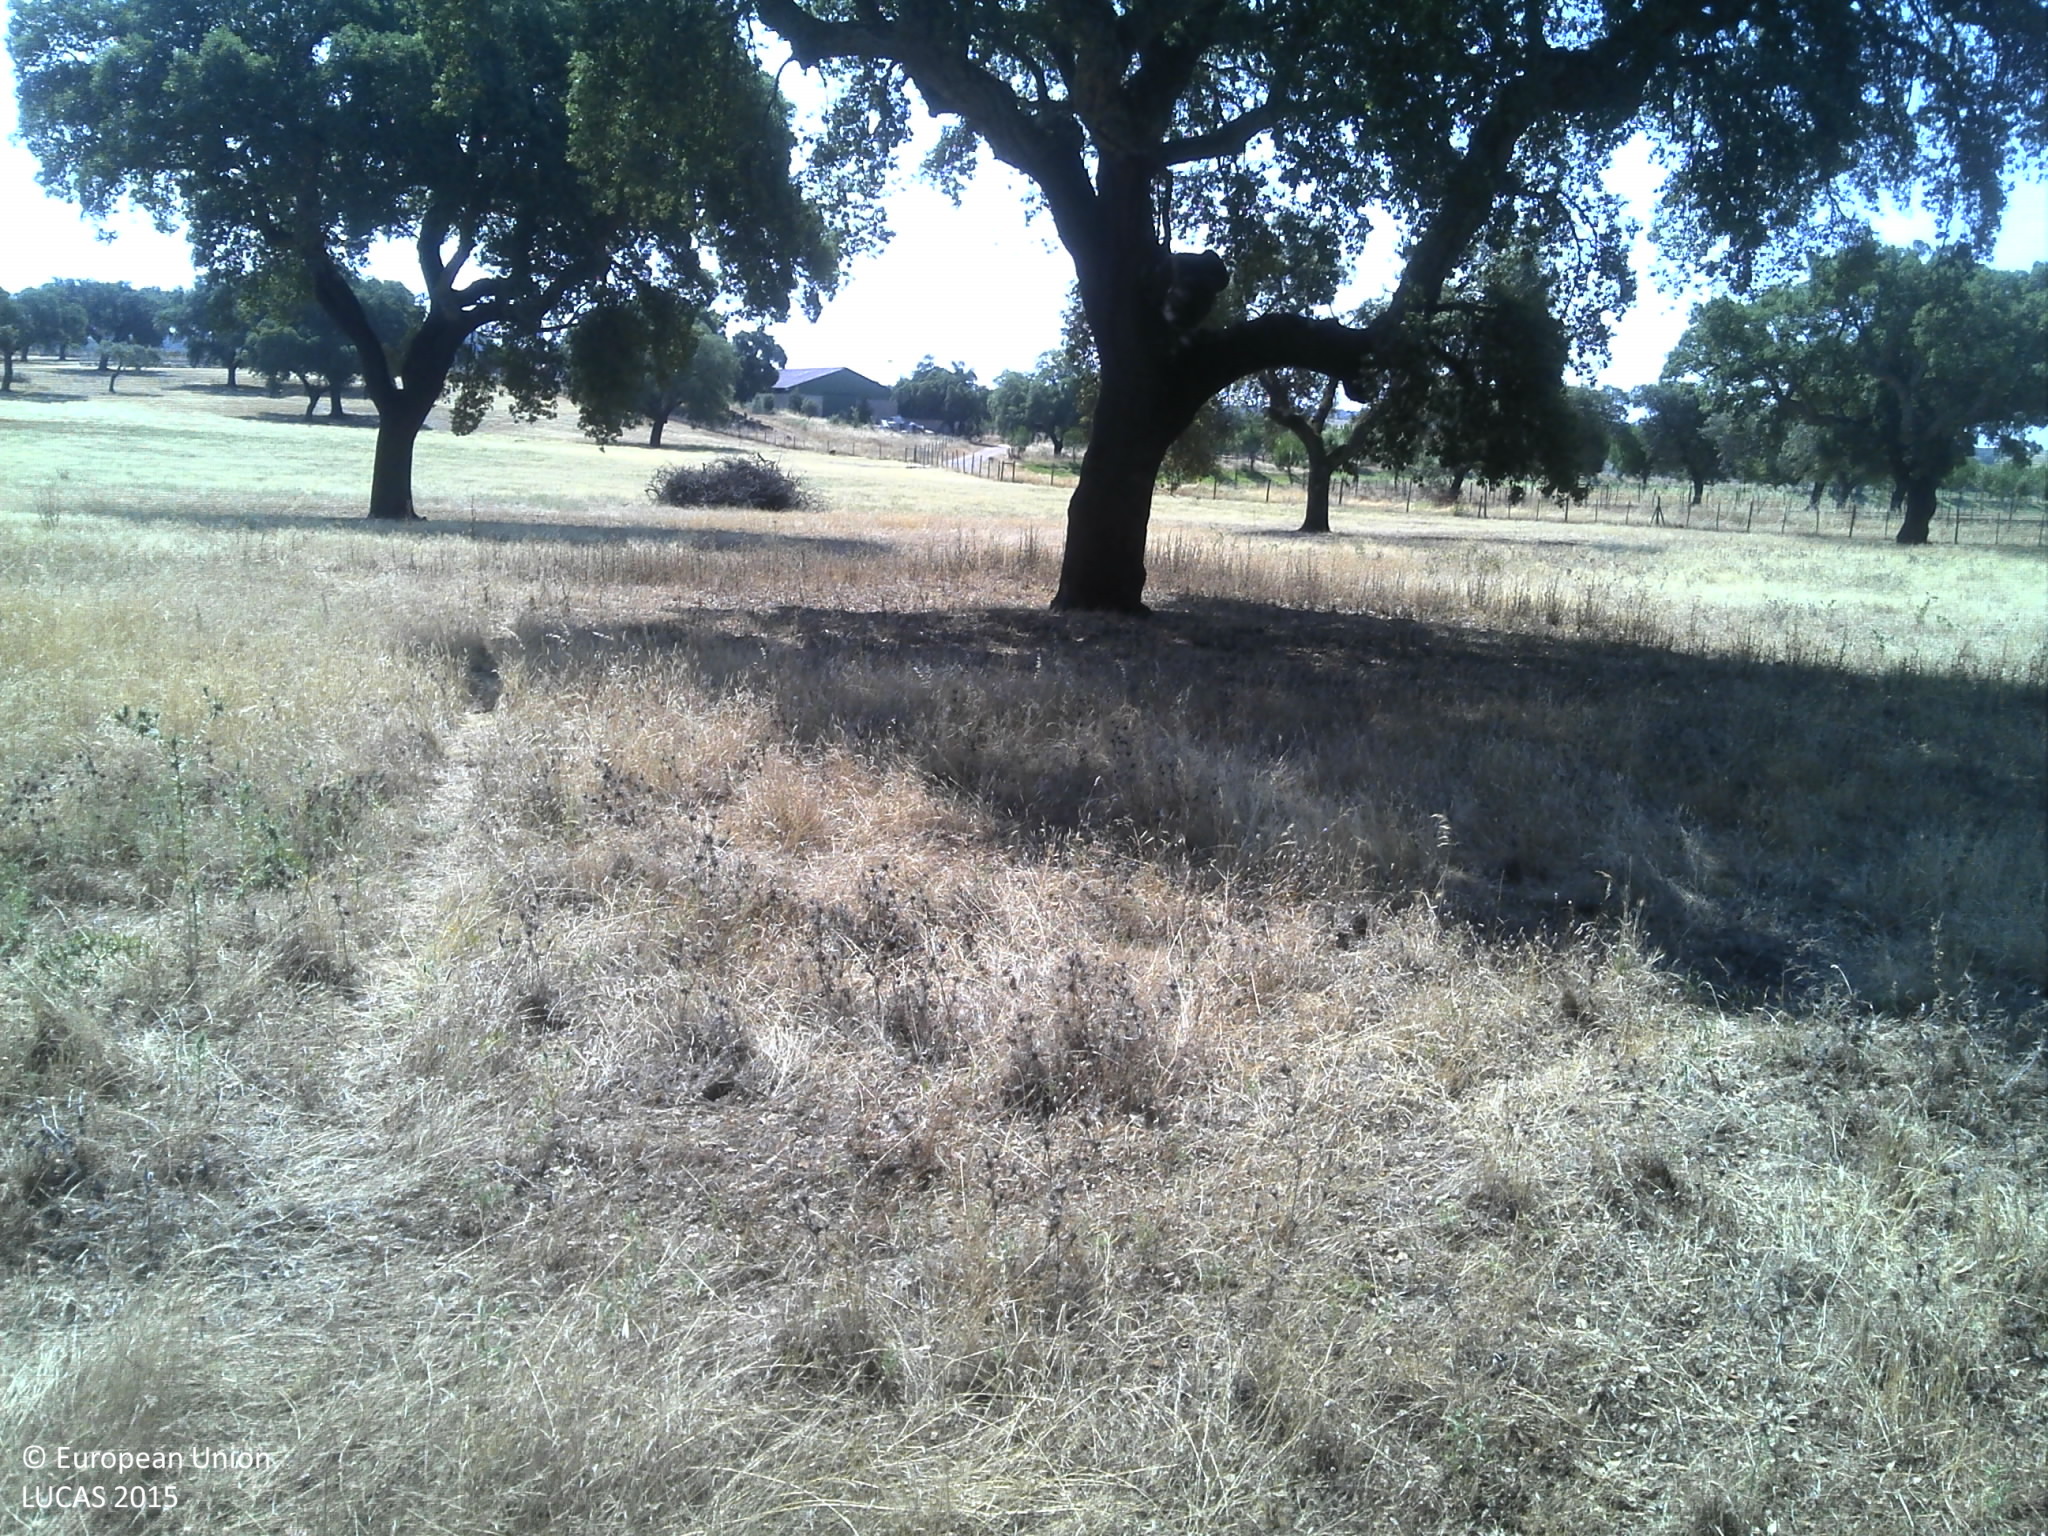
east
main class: Woodland
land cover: Broadleaved woodland
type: broadleaved evergreen forest
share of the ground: 25 - 50 %
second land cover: Grassland without tree/shrub cover
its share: 25 - 50 %
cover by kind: broadleaved forest trees 40 %, herbaceous plants 40 %, unconsolidated bare surface 15 %
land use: Forestry
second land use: Agriculture (excluding fallow land and kitchen gardens)
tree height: > 5 m
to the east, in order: Broadleaved woodland; Grassland without tree/shrub cover; Broadleaved woodland; Grassland without tree/shrub cover; Broadleaved woodland; Fences; Grass margins; Tracks
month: June
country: PT
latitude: 39.9036
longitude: -7.0624
